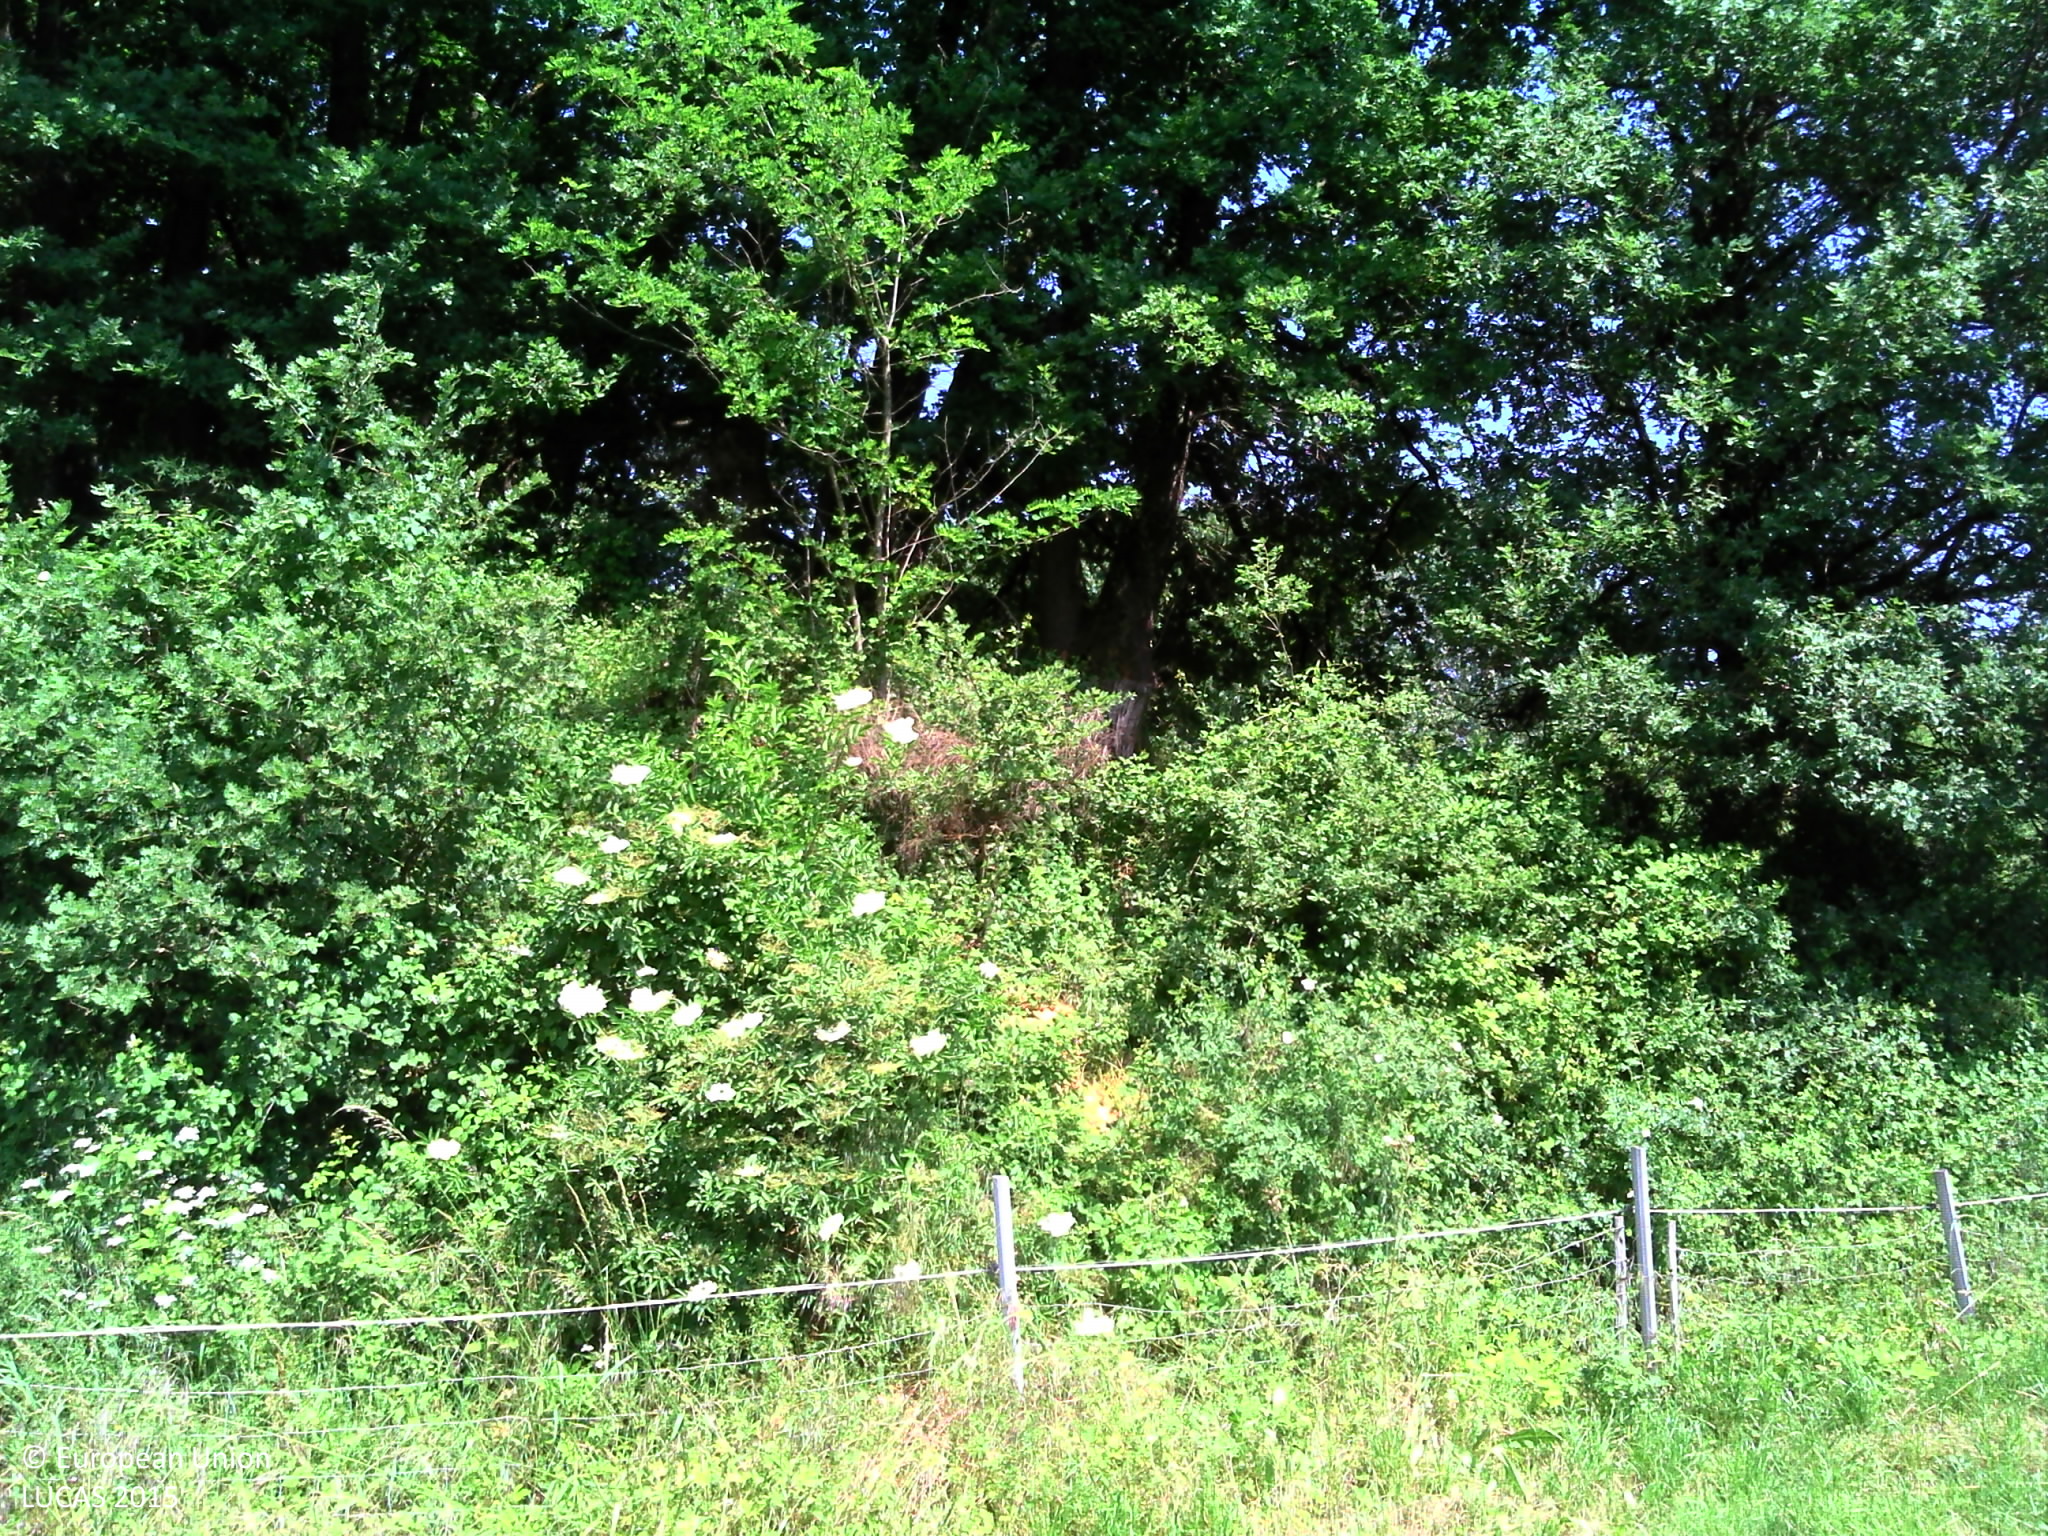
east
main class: Grassland
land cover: Grassland without tree/shrub cover
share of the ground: > 75 %
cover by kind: herbaceous plants 100 %
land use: Agriculture (excluding fallow land and kitchen gardens)
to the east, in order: Grassland without tree/shrub cover; Fences; Ditches and canals; Broadleaved woodland; Grassland without tree/shrub cover; Inland fresh water bodies; Broadleaved woodland; Fences; Paved roads, cycling and walking lanes; Grass margins; Ditches and canals; Other bare soil; Tracks; Broadleaved woodland; Grassland without tree/shrub cover; Nuts trees
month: May
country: FR
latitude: 45.0748
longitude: 4.9117
